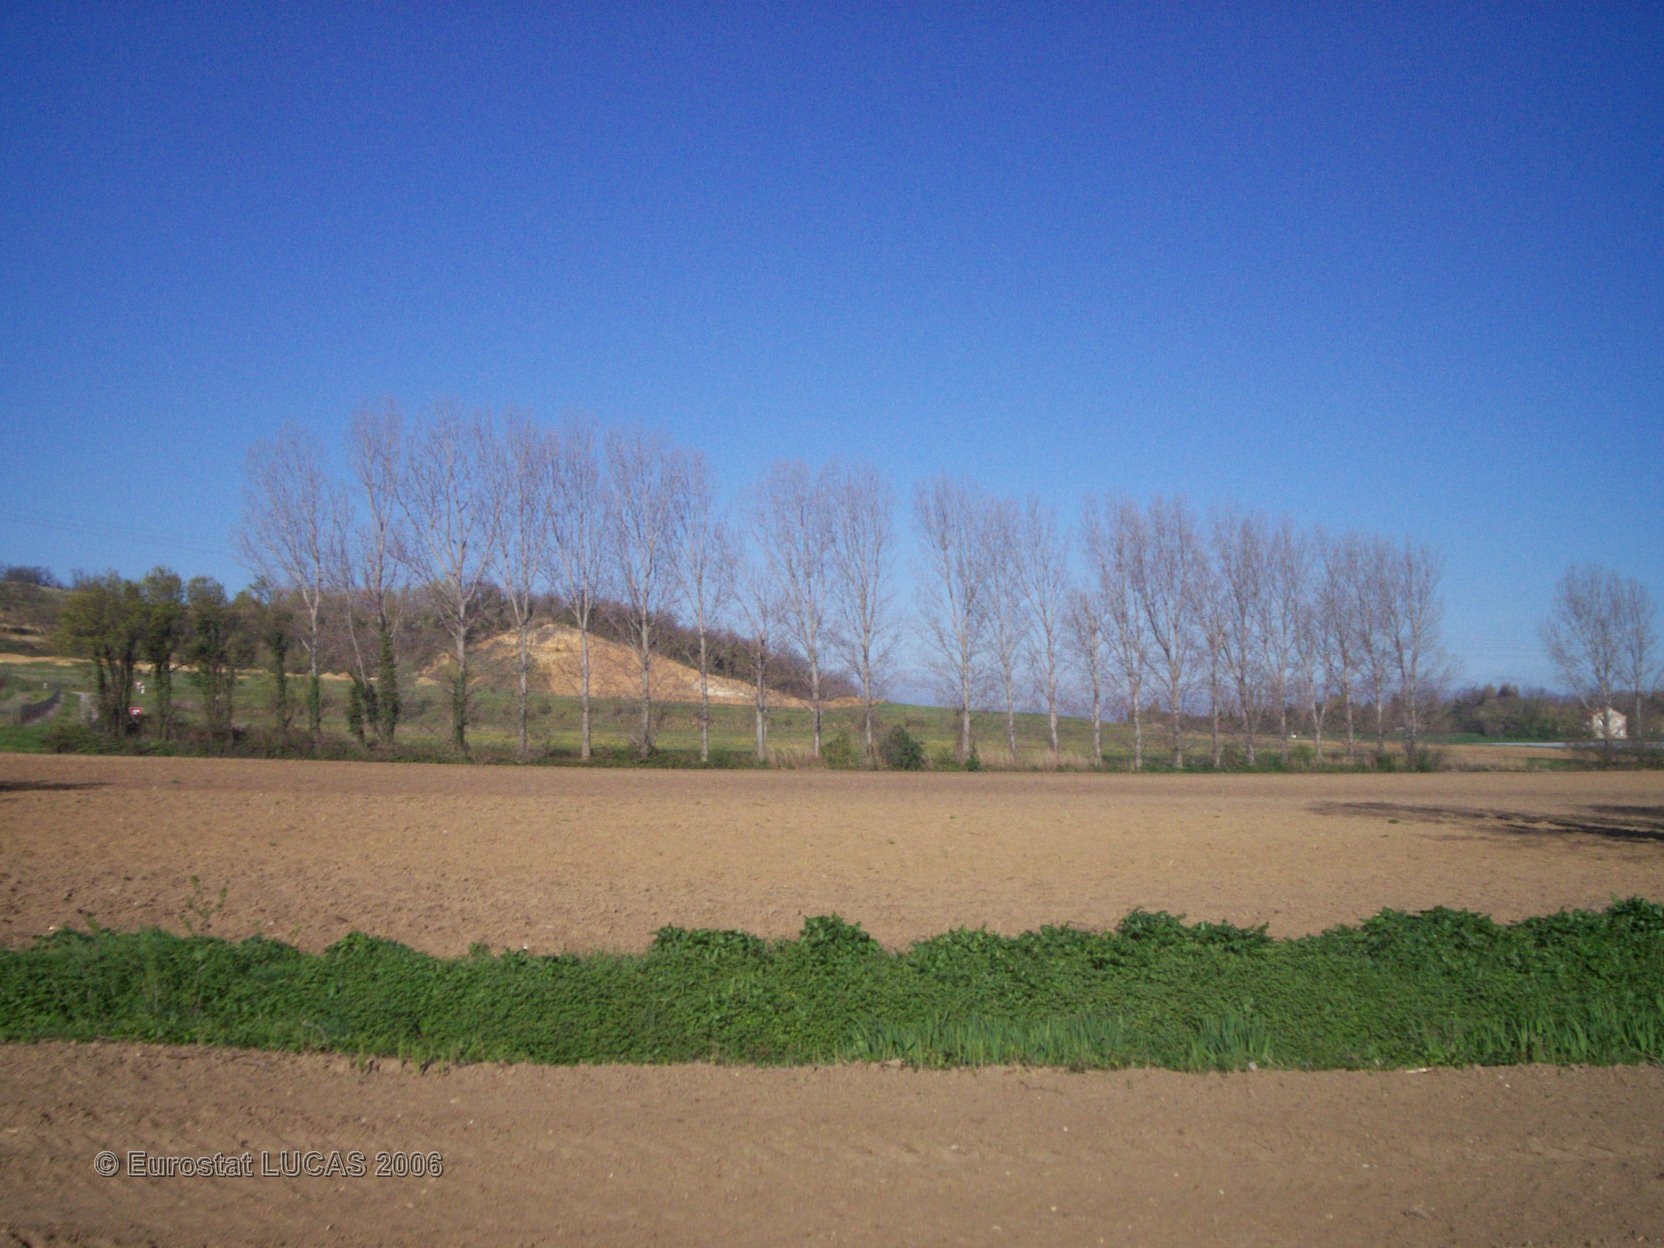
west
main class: Cropland
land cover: Other fresh vegetables
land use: Agriculture (excluding fallow land and kitchen gardens)
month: April
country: FR
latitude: 44.8038
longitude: 4.9110
